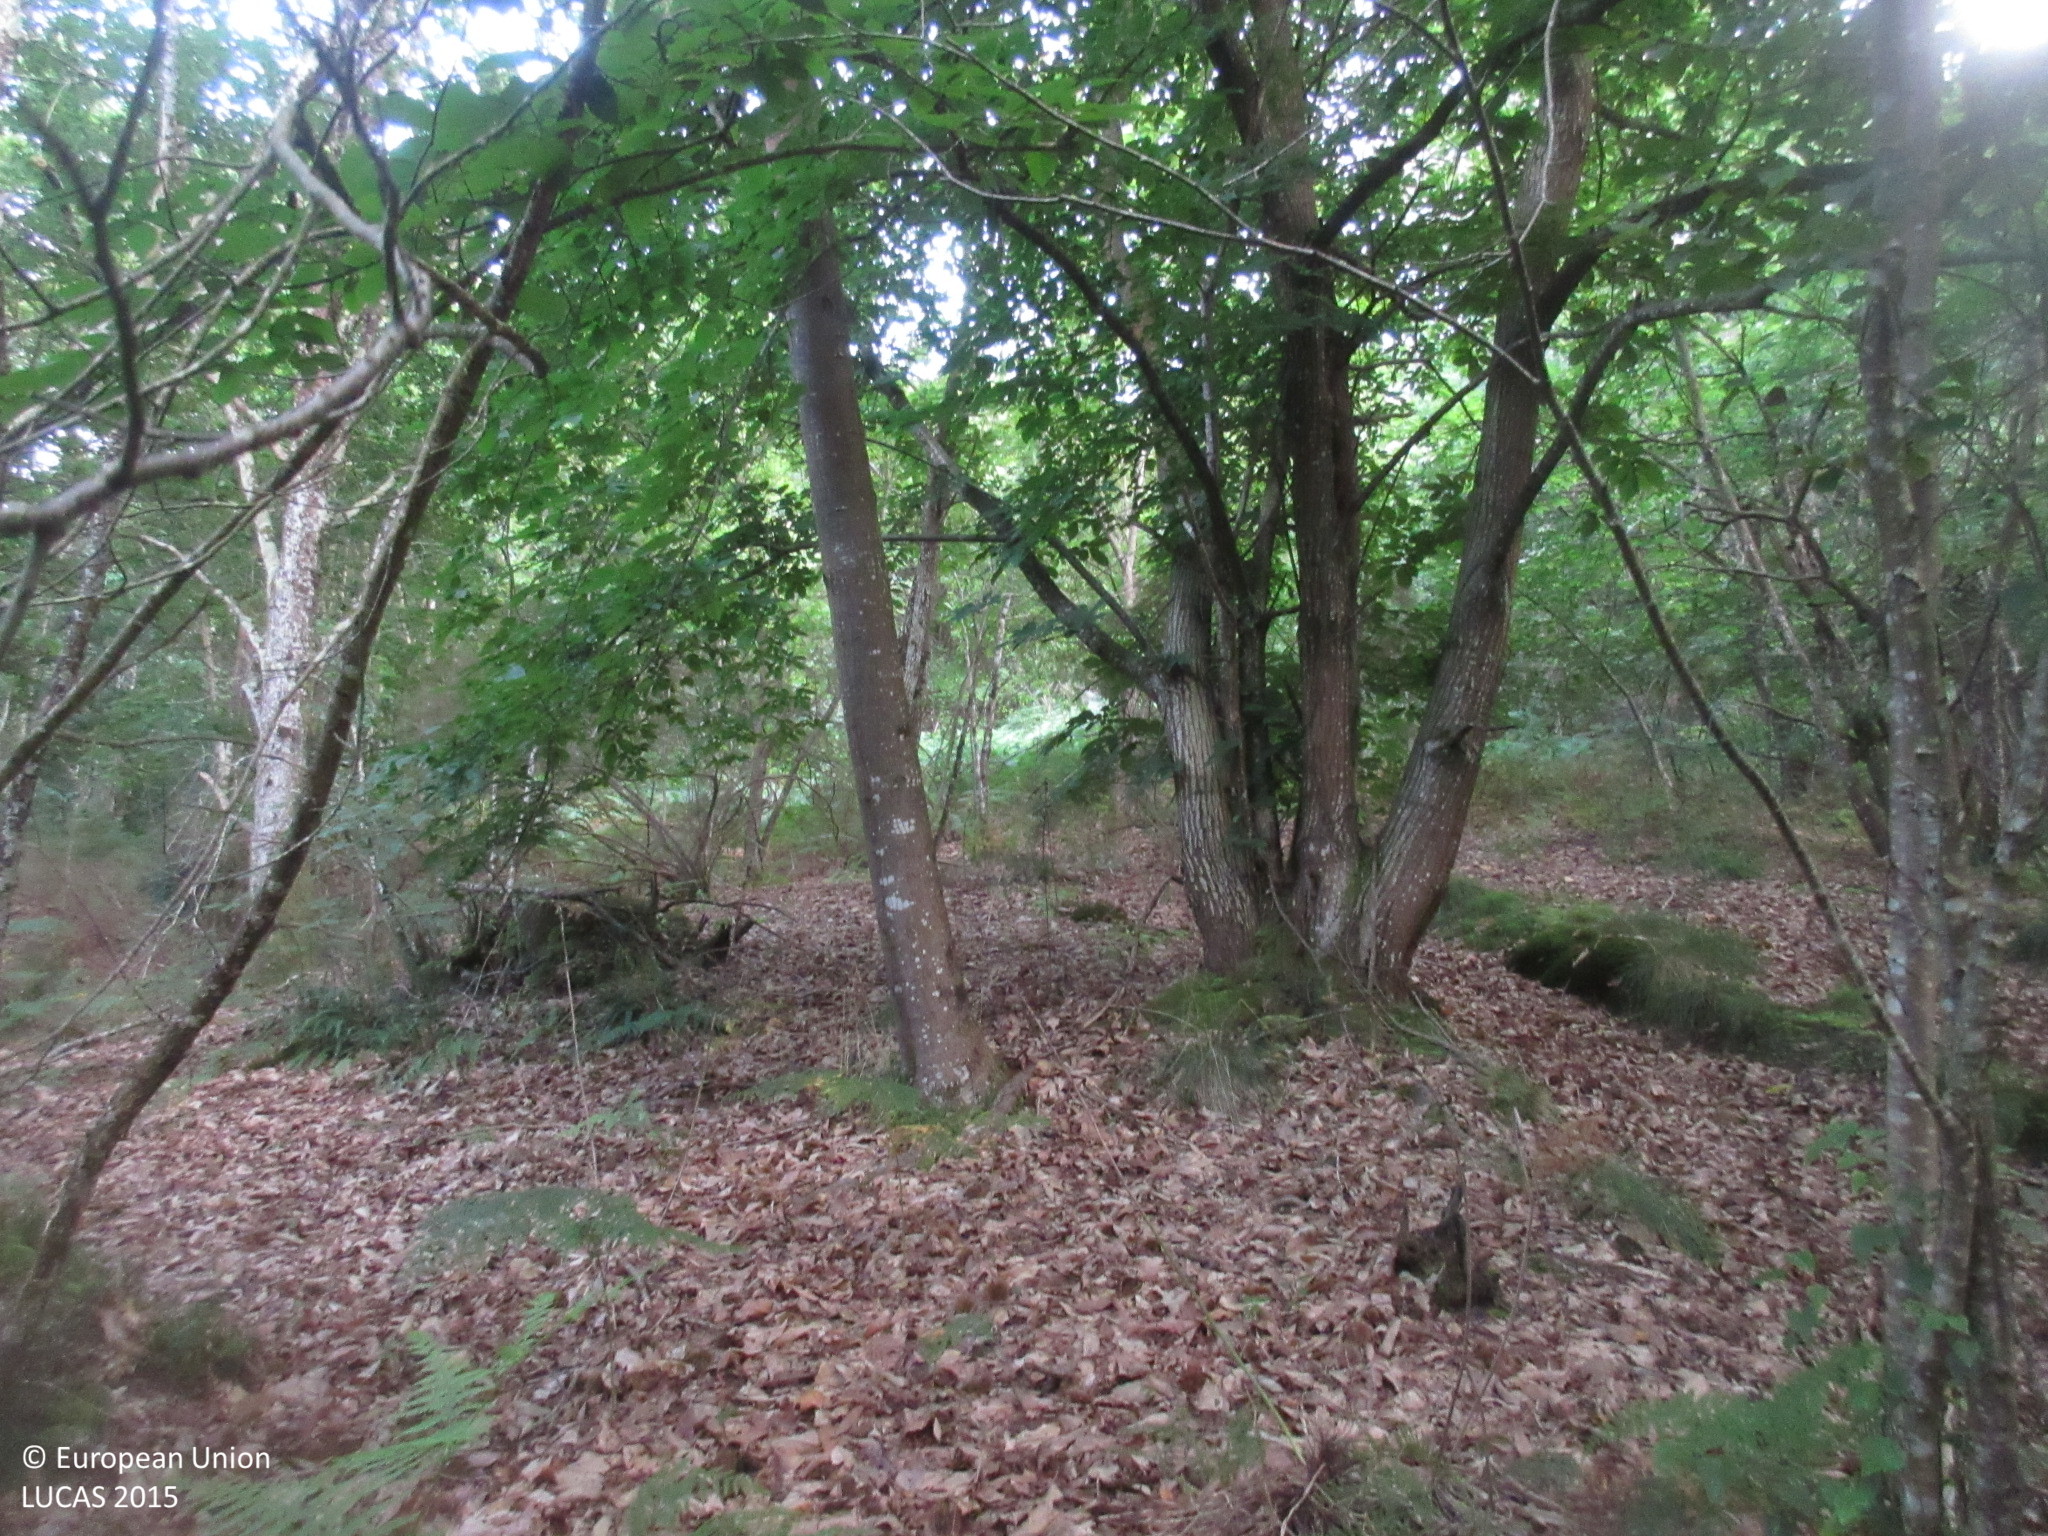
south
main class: Woodland
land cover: Broadleaved woodland
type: thermophilous deciduous forest
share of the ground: > 75 %
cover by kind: broadleaved forest trees 100 %
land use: Forestry
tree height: > 5 m
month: July
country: ES
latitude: 43.3994
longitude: -5.1236
